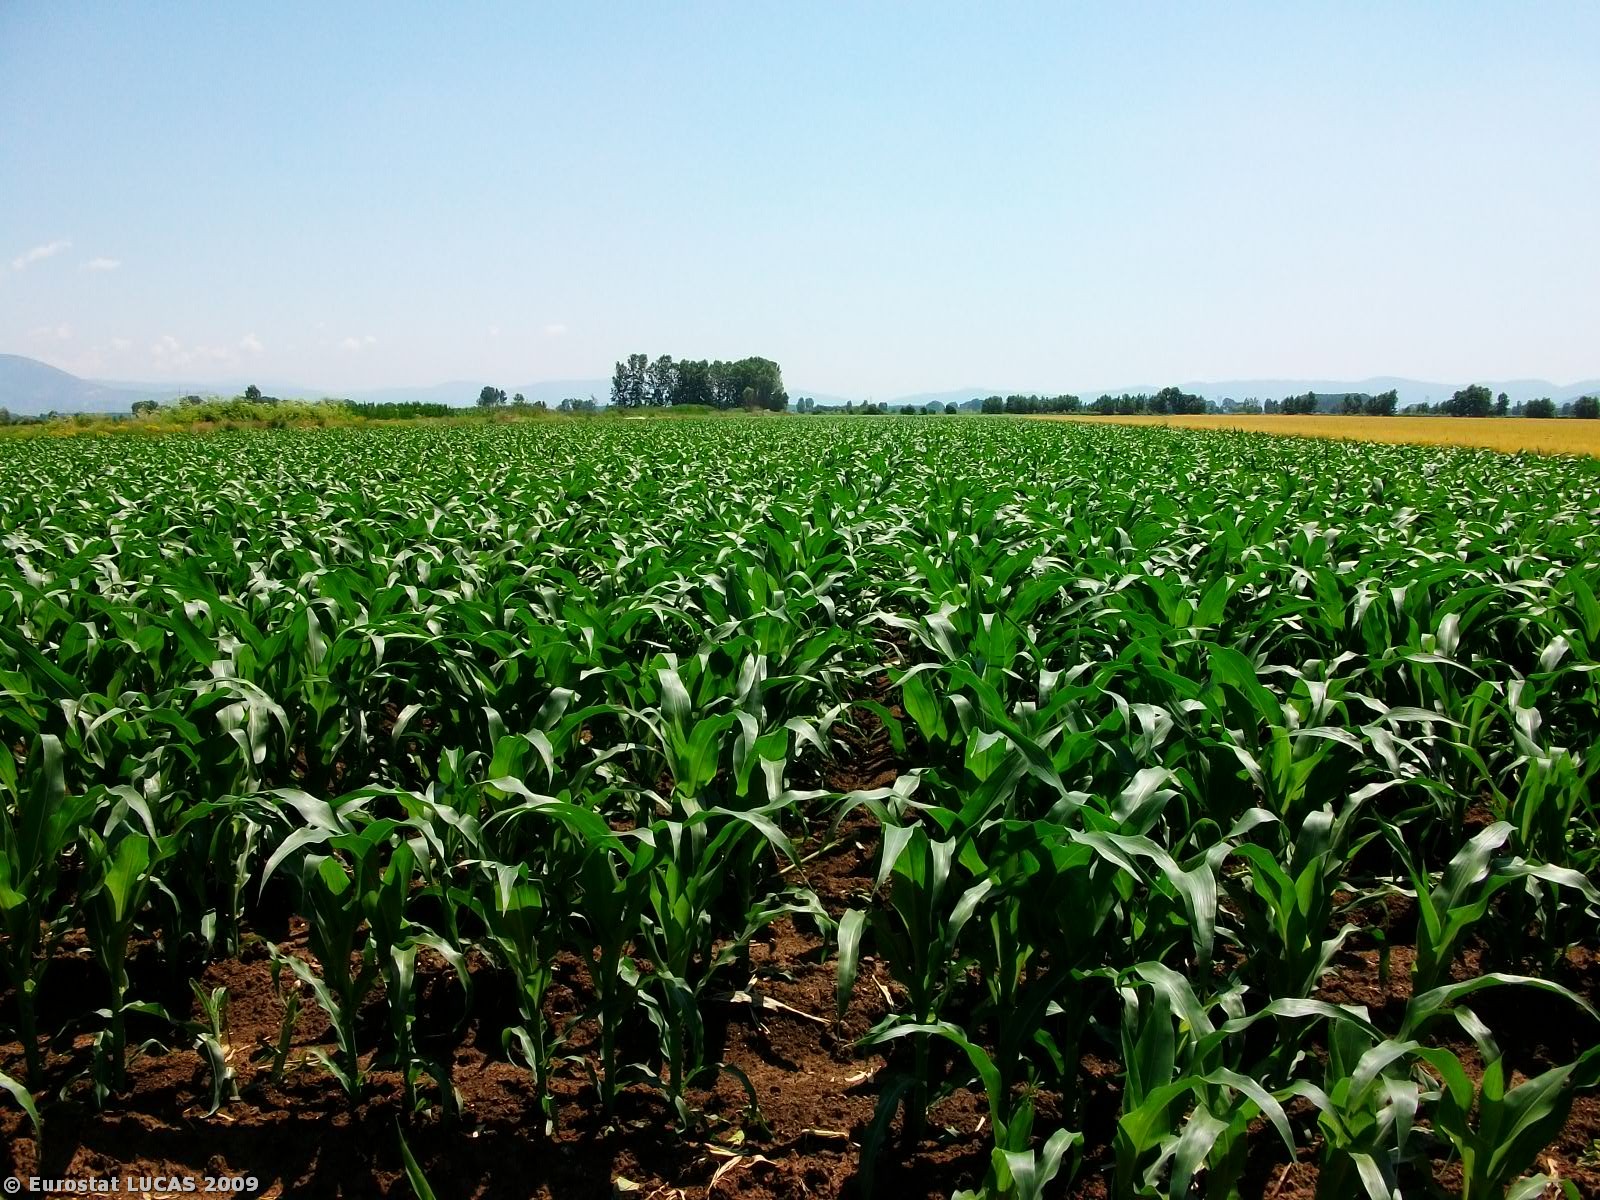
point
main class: Cropland
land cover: Maize
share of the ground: > 75 %
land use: Agriculture (excluding fallow land and kitchen gardens)
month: June
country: GR
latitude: 41.0150
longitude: 24.1426
